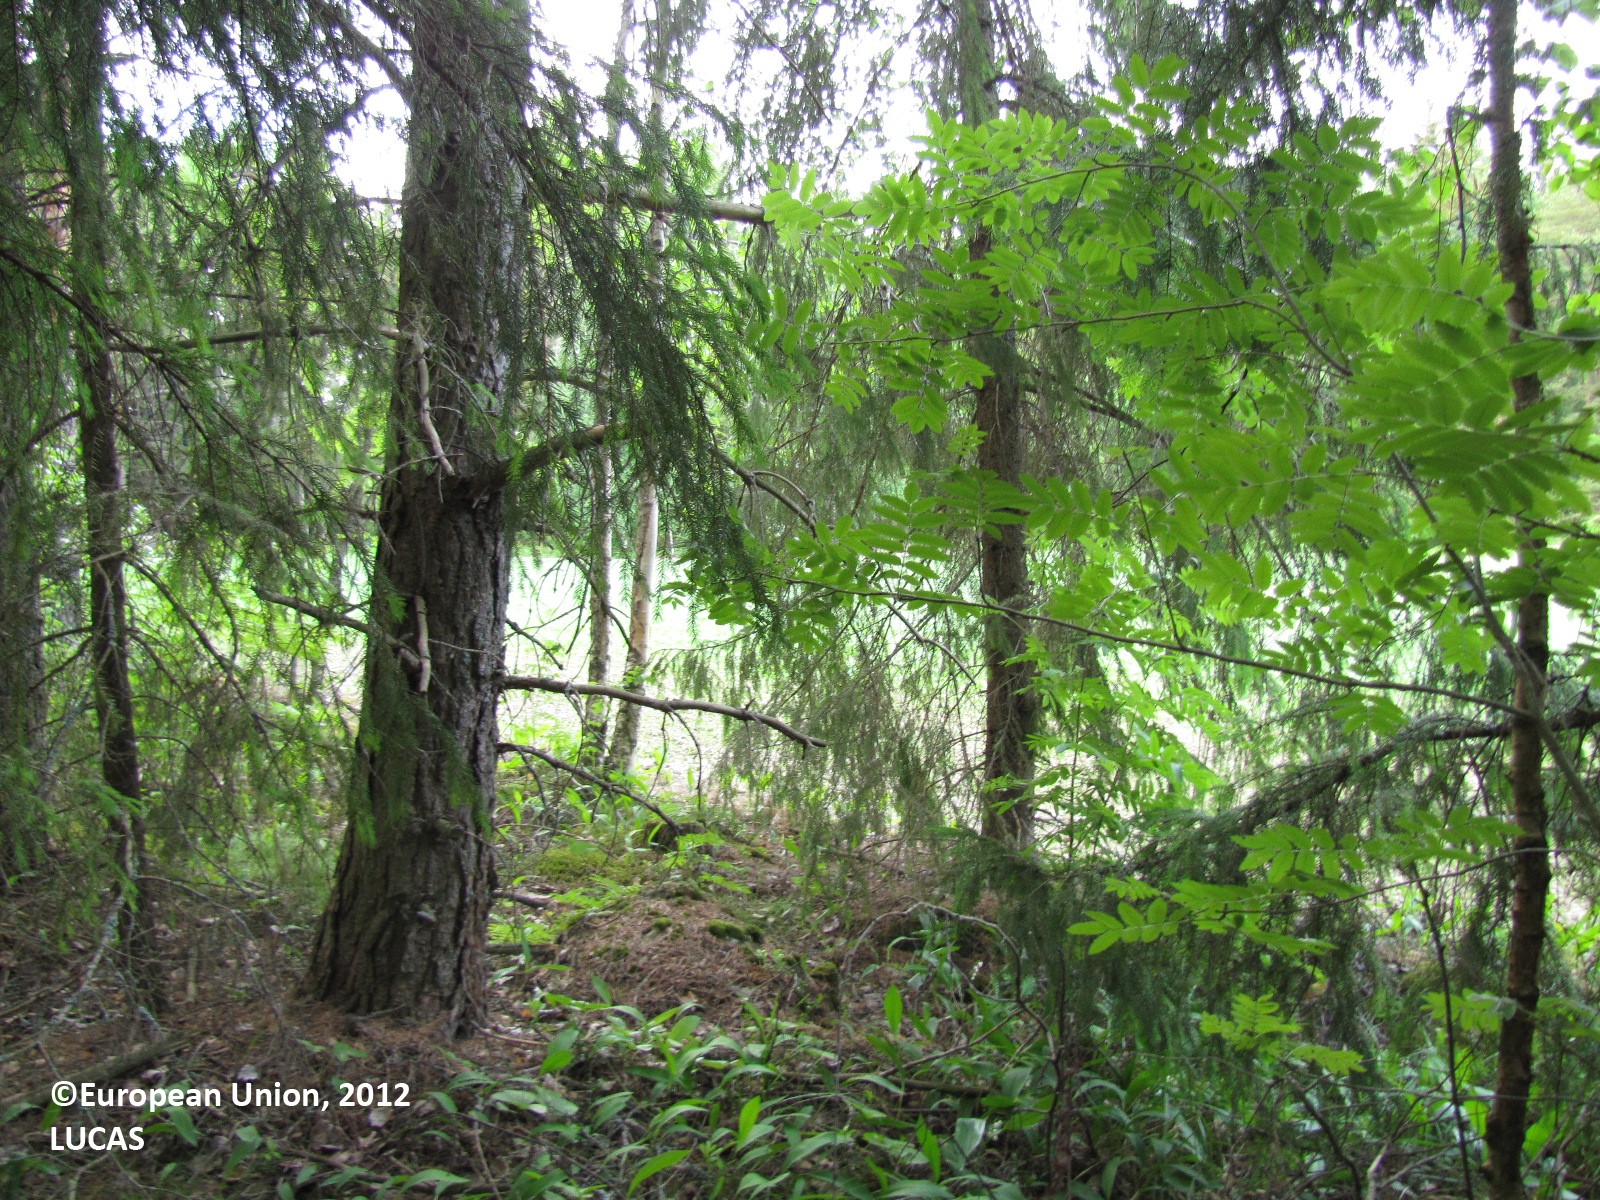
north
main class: Woodland
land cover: Spruce dominated coniferous woodland
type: boreal forest
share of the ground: 25 - 50 %
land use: Forestry
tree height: > 5 m
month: June
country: FI
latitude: 61.4897
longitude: 24.4266
